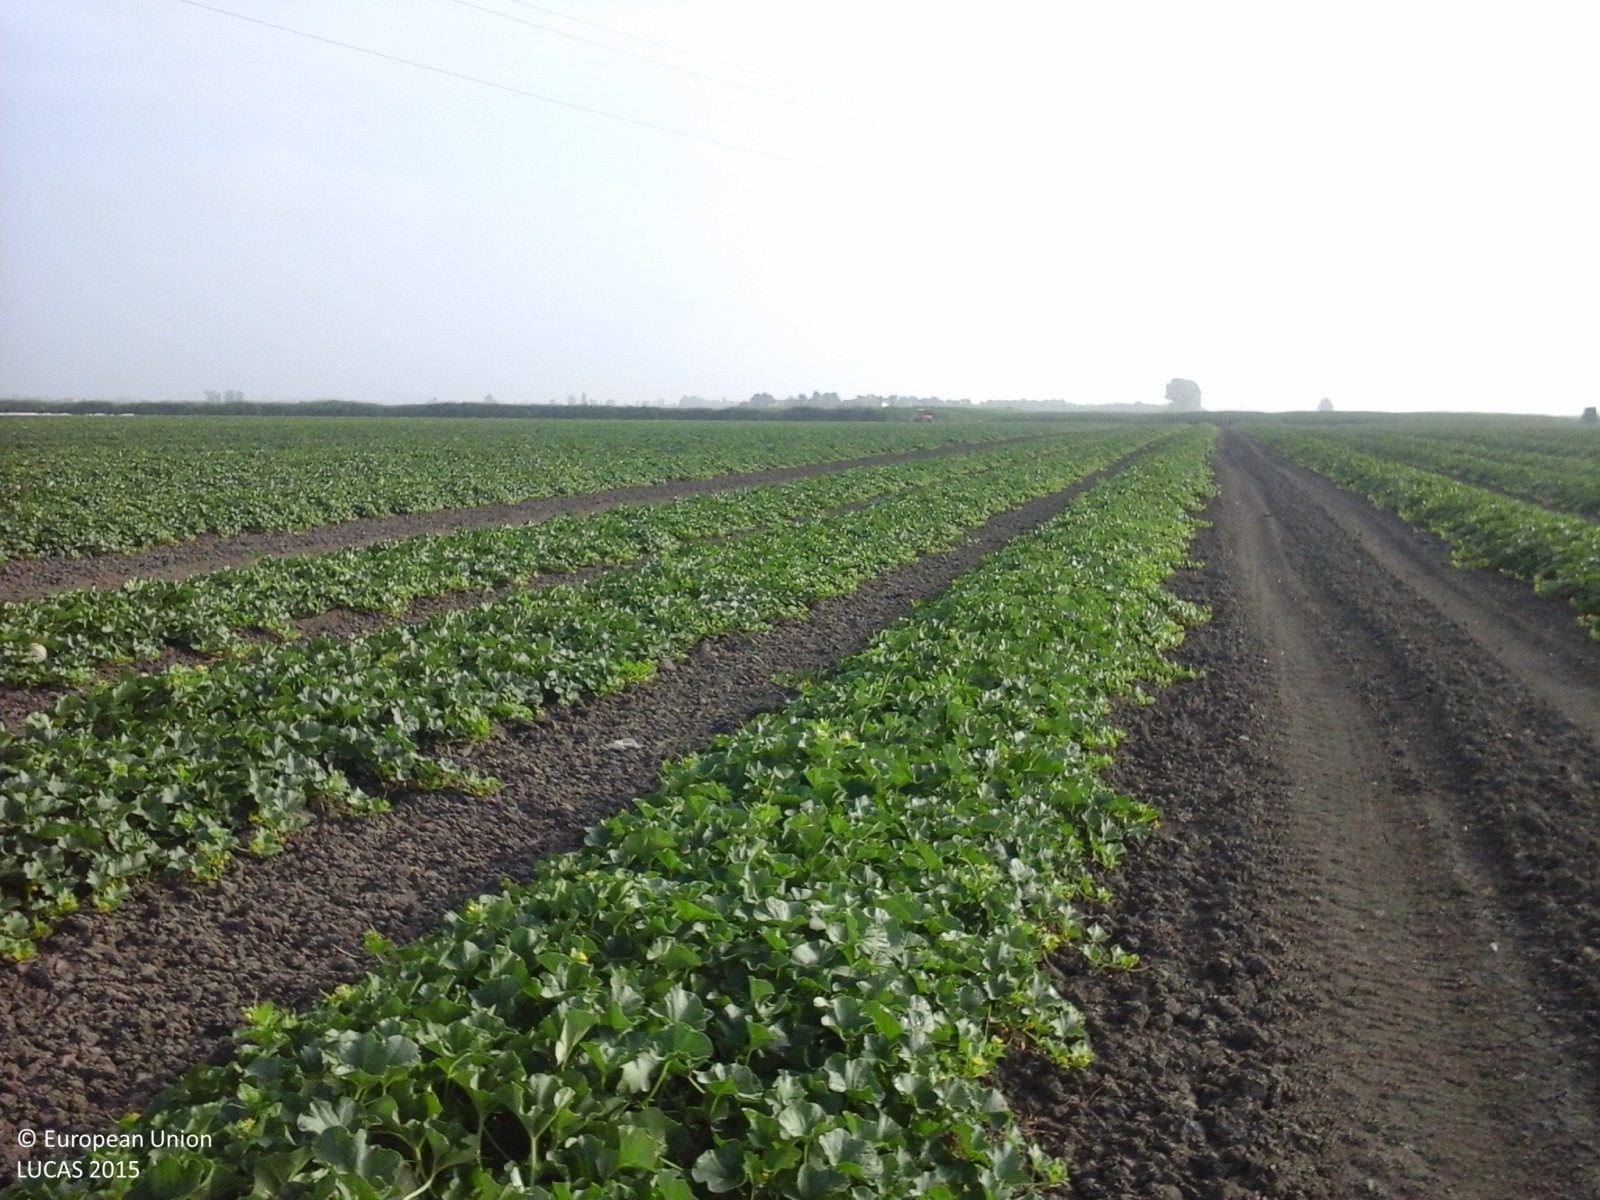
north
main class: Cropland
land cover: Other fresh vegetables
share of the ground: 50 - 75 %
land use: Agriculture (excluding fallow land and kitchen gardens)
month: June
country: IT
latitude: 44.9396
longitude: 11.1257
